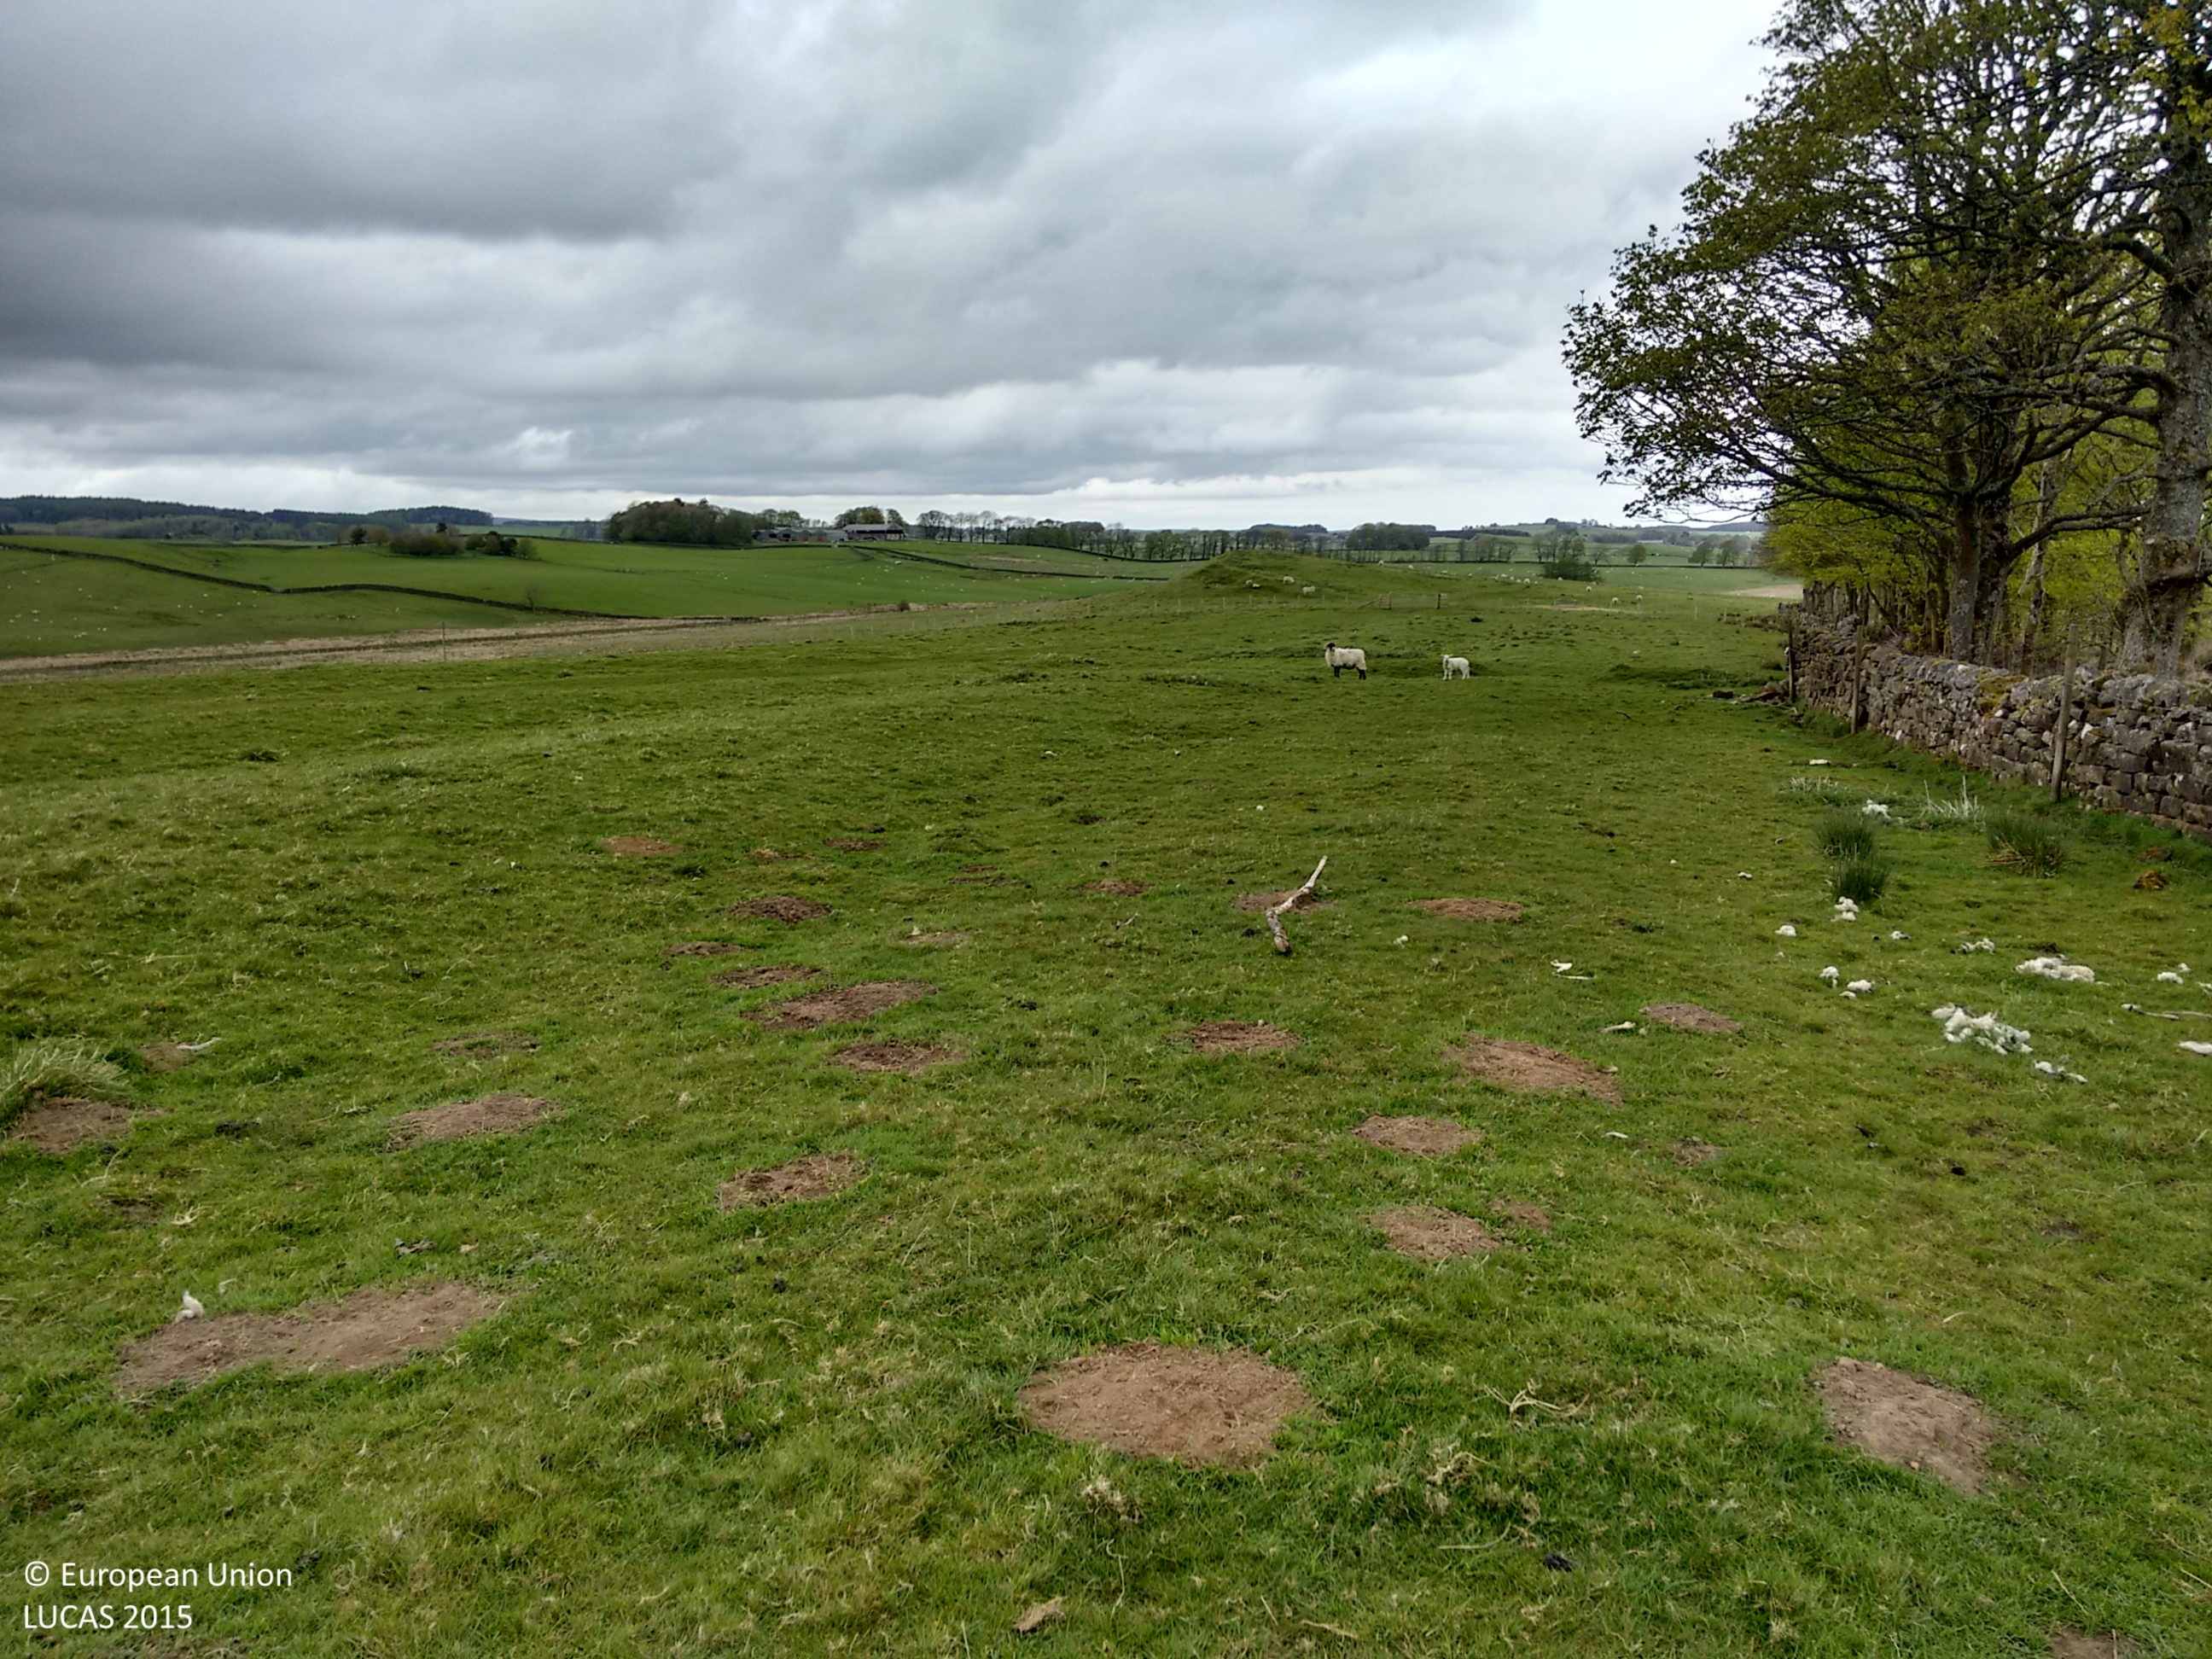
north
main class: Grassland
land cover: Grassland without tree/shrub cover
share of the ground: > 75 %
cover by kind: herbaceous plants 100 %
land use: Agriculture (excluding fallow land and kitchen gardens)
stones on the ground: < 10 %
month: May
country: GB
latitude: 55.1435
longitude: -2.0572
